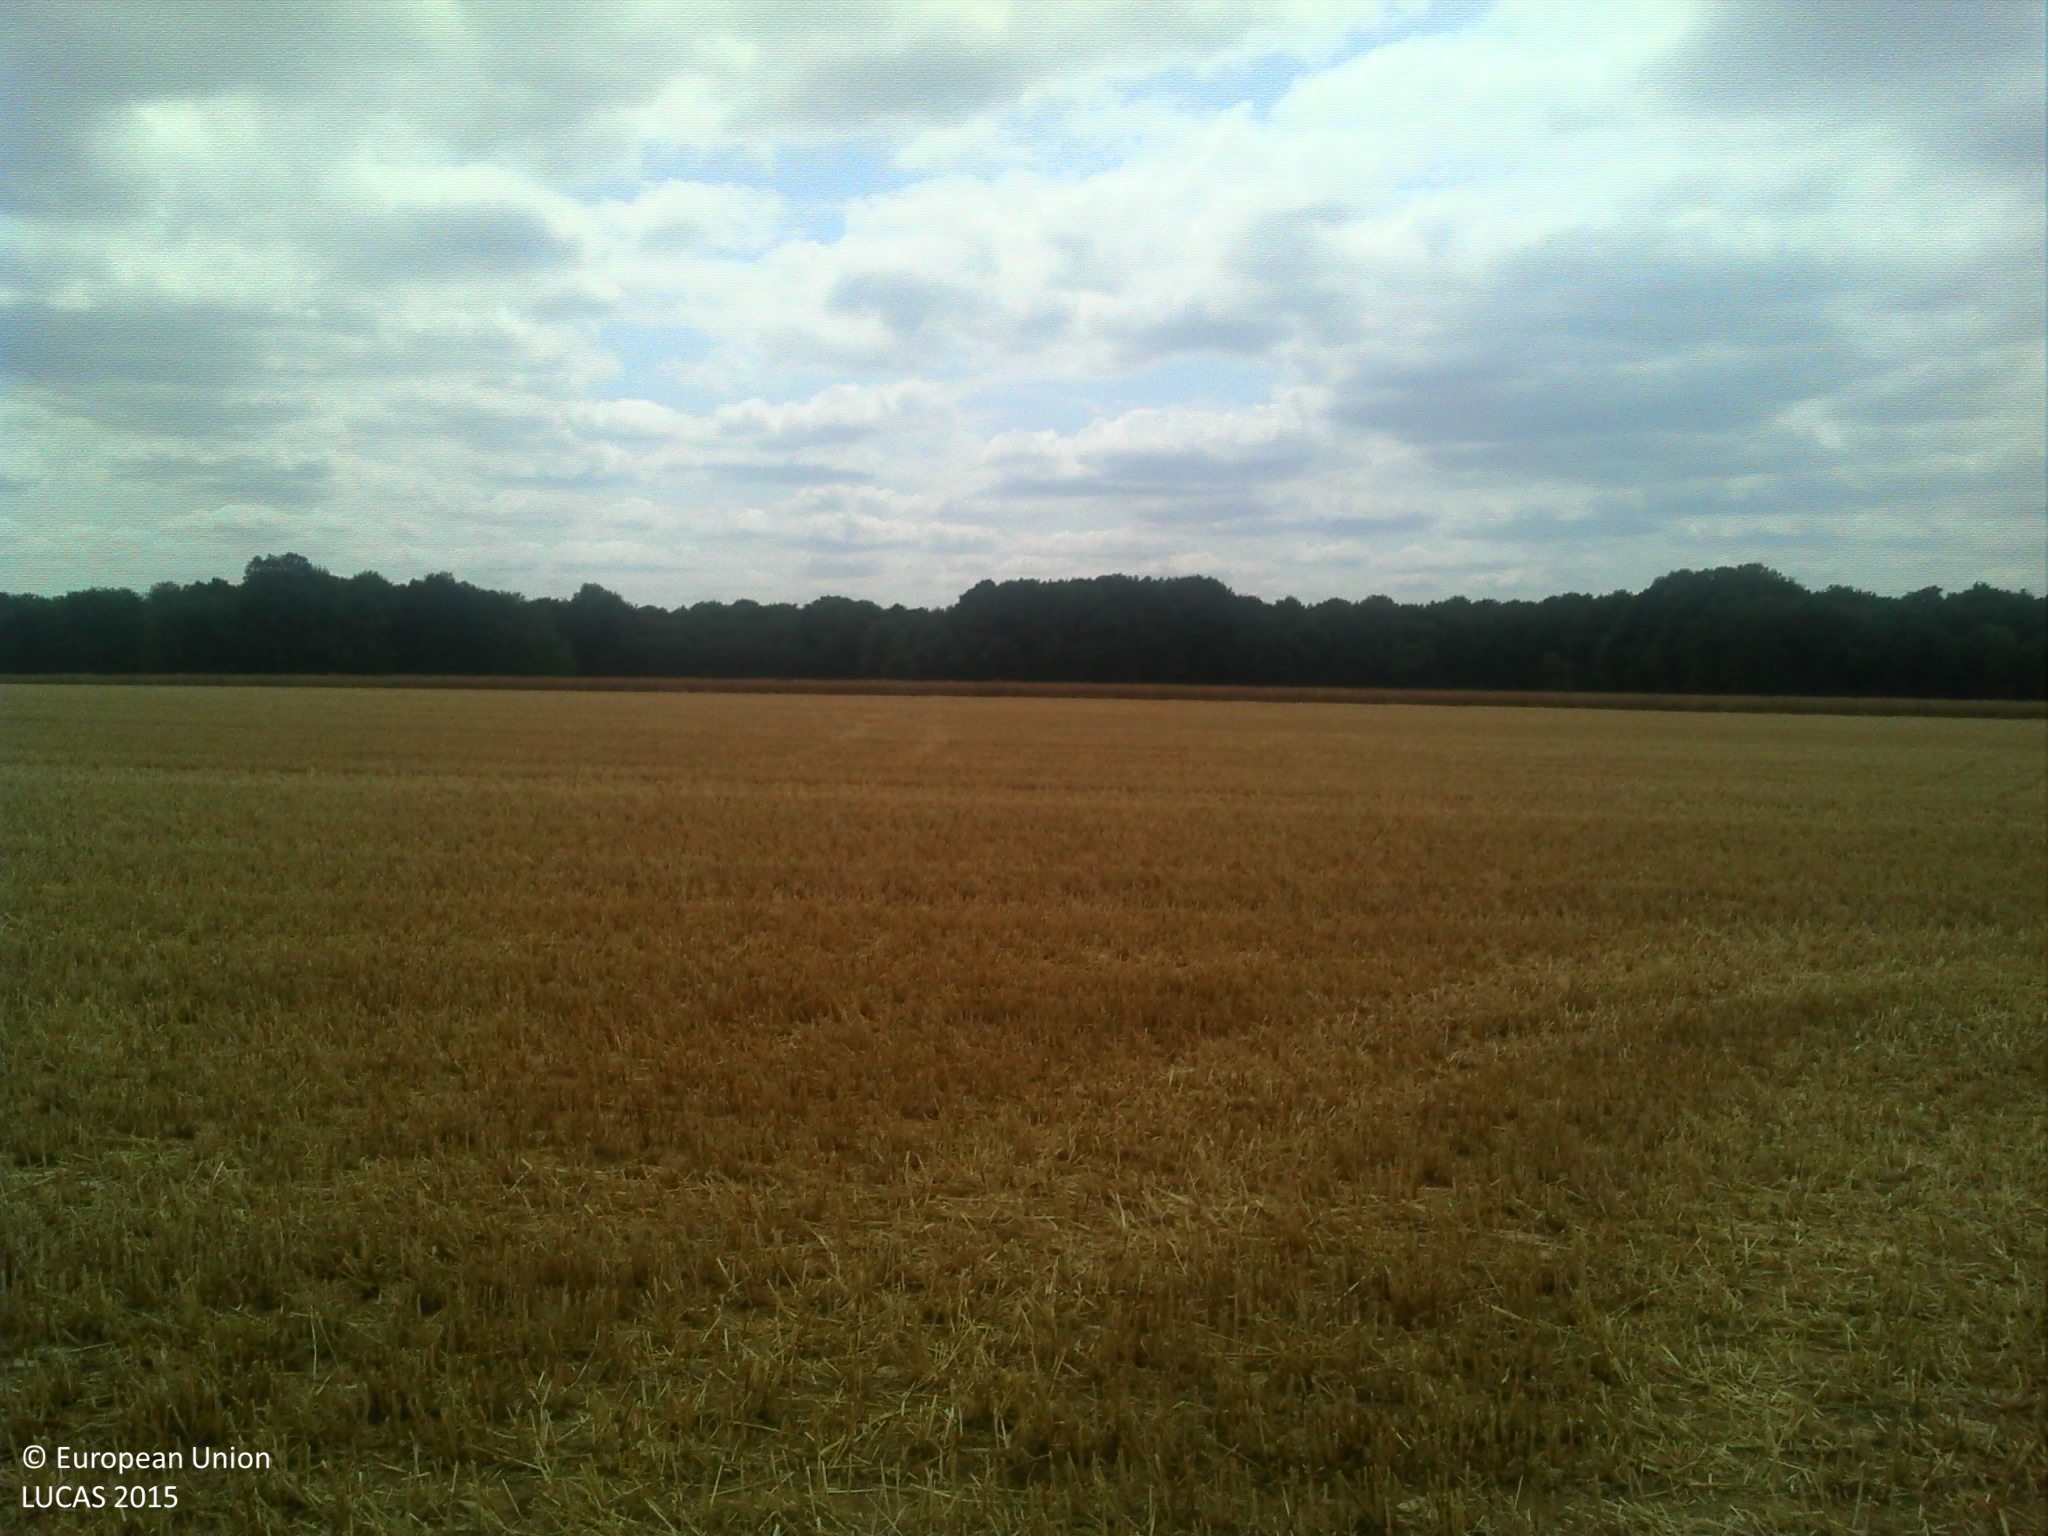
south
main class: Cropland
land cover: Barley
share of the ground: 10 - 25 %
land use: Agriculture (excluding fallow land and kitchen gardens)
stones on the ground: < 10 %
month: July
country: FR
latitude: 48.0044
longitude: 5.0533
